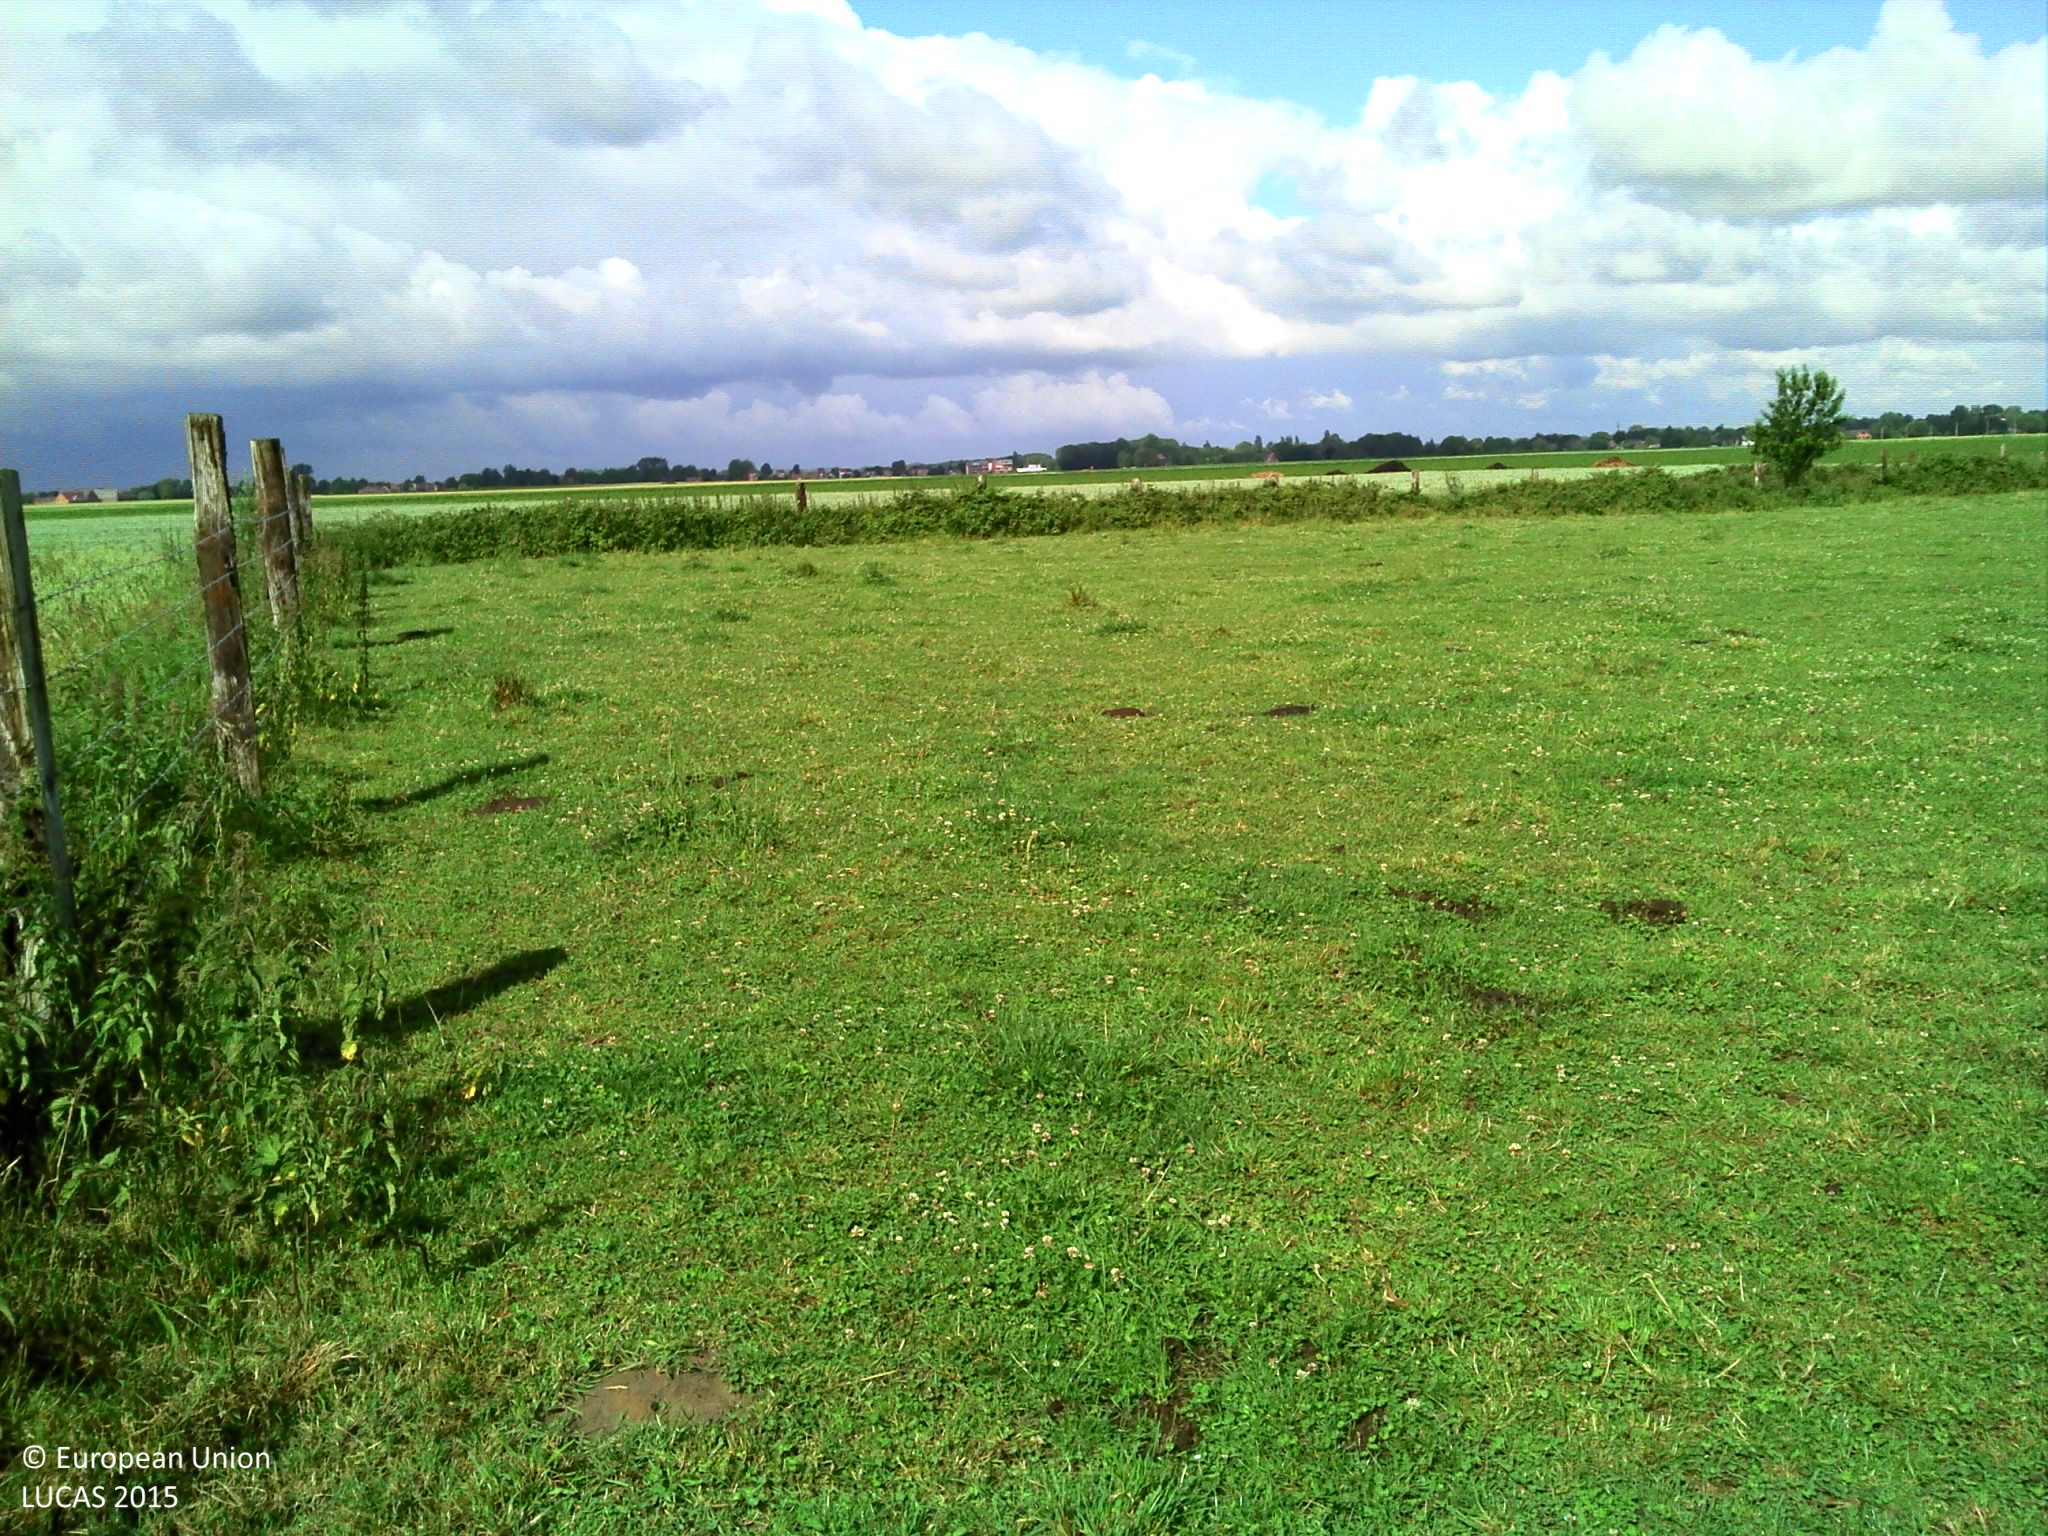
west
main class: Grassland
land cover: Grassland with sparse tree/shrub cover
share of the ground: 50 - 75 %
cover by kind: herbaceous plants 85 %, shrubs 10 %, broadleaved forest trees 5 %
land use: Agriculture (excluding fallow land and kitchen gardens)
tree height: > 5 m
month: June
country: BE
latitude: 50.5281
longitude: 3.9422
